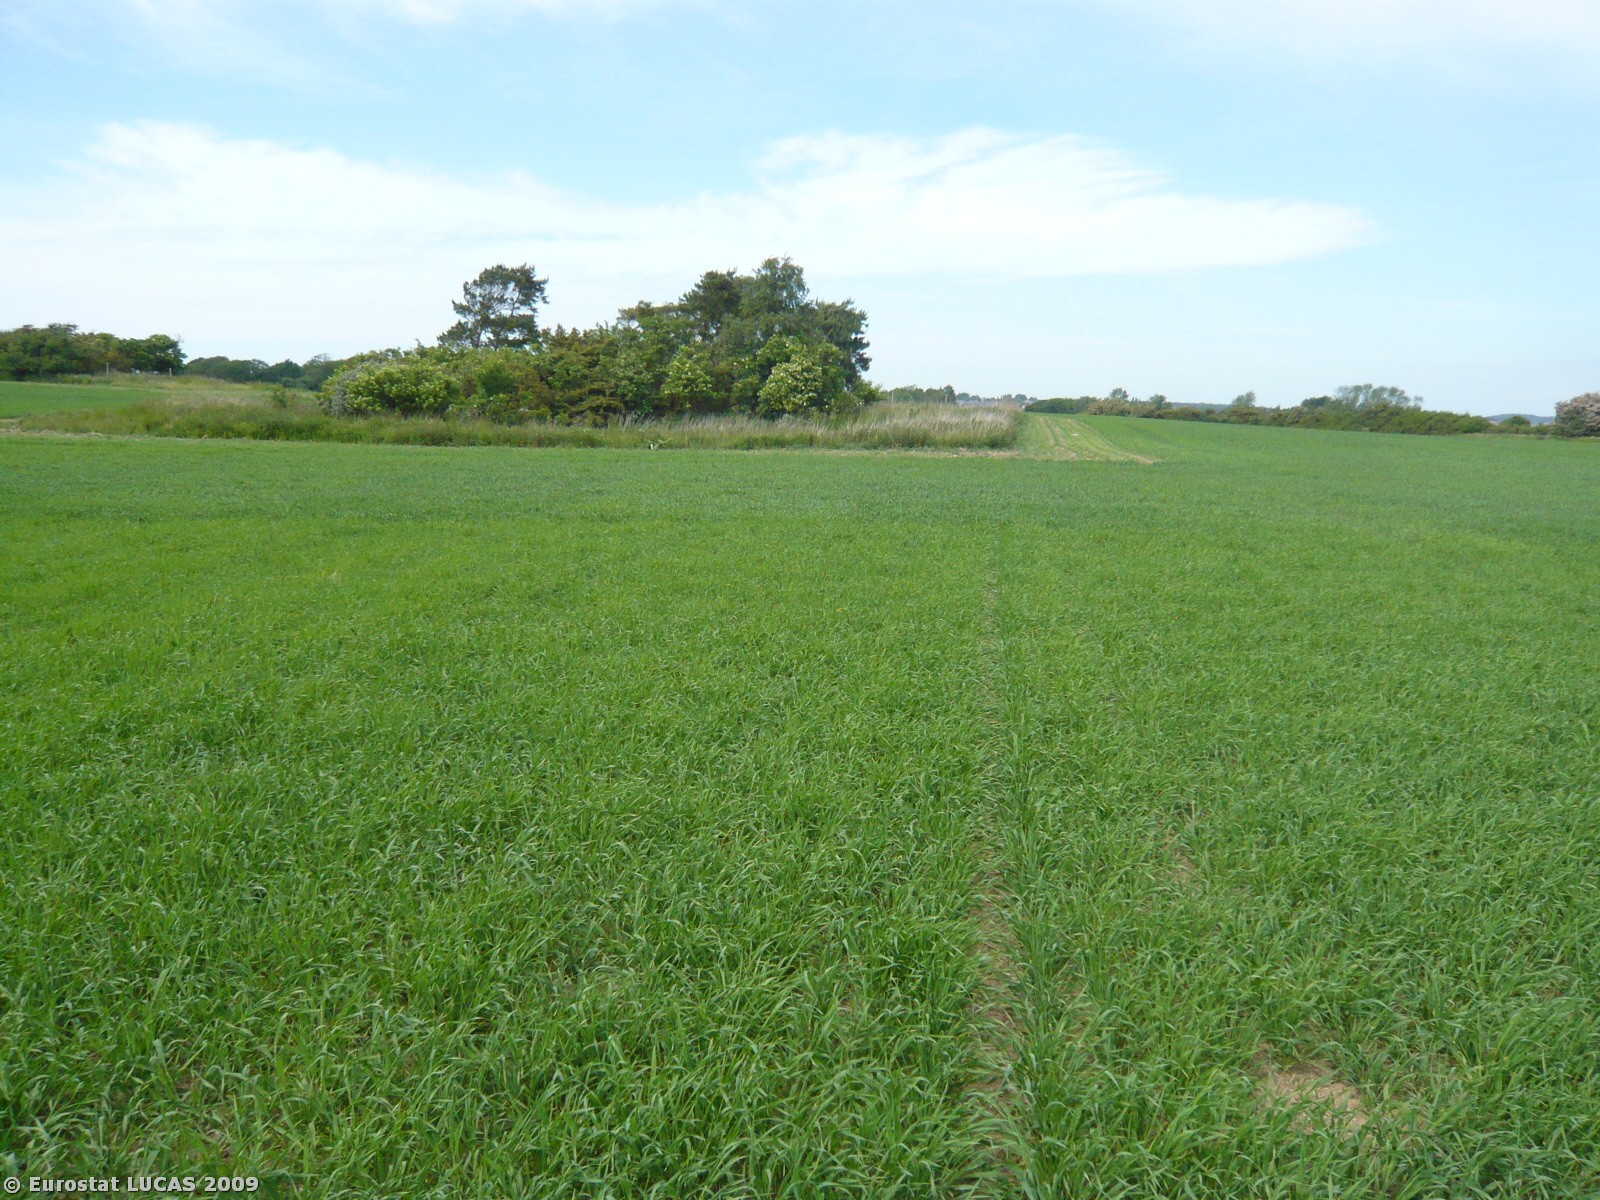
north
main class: Cropland
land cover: Barley
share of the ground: > 75 %
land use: Agriculture (excluding fallow land and kitchen gardens)
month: June
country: DK
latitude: 55.2287
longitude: 11.2725
